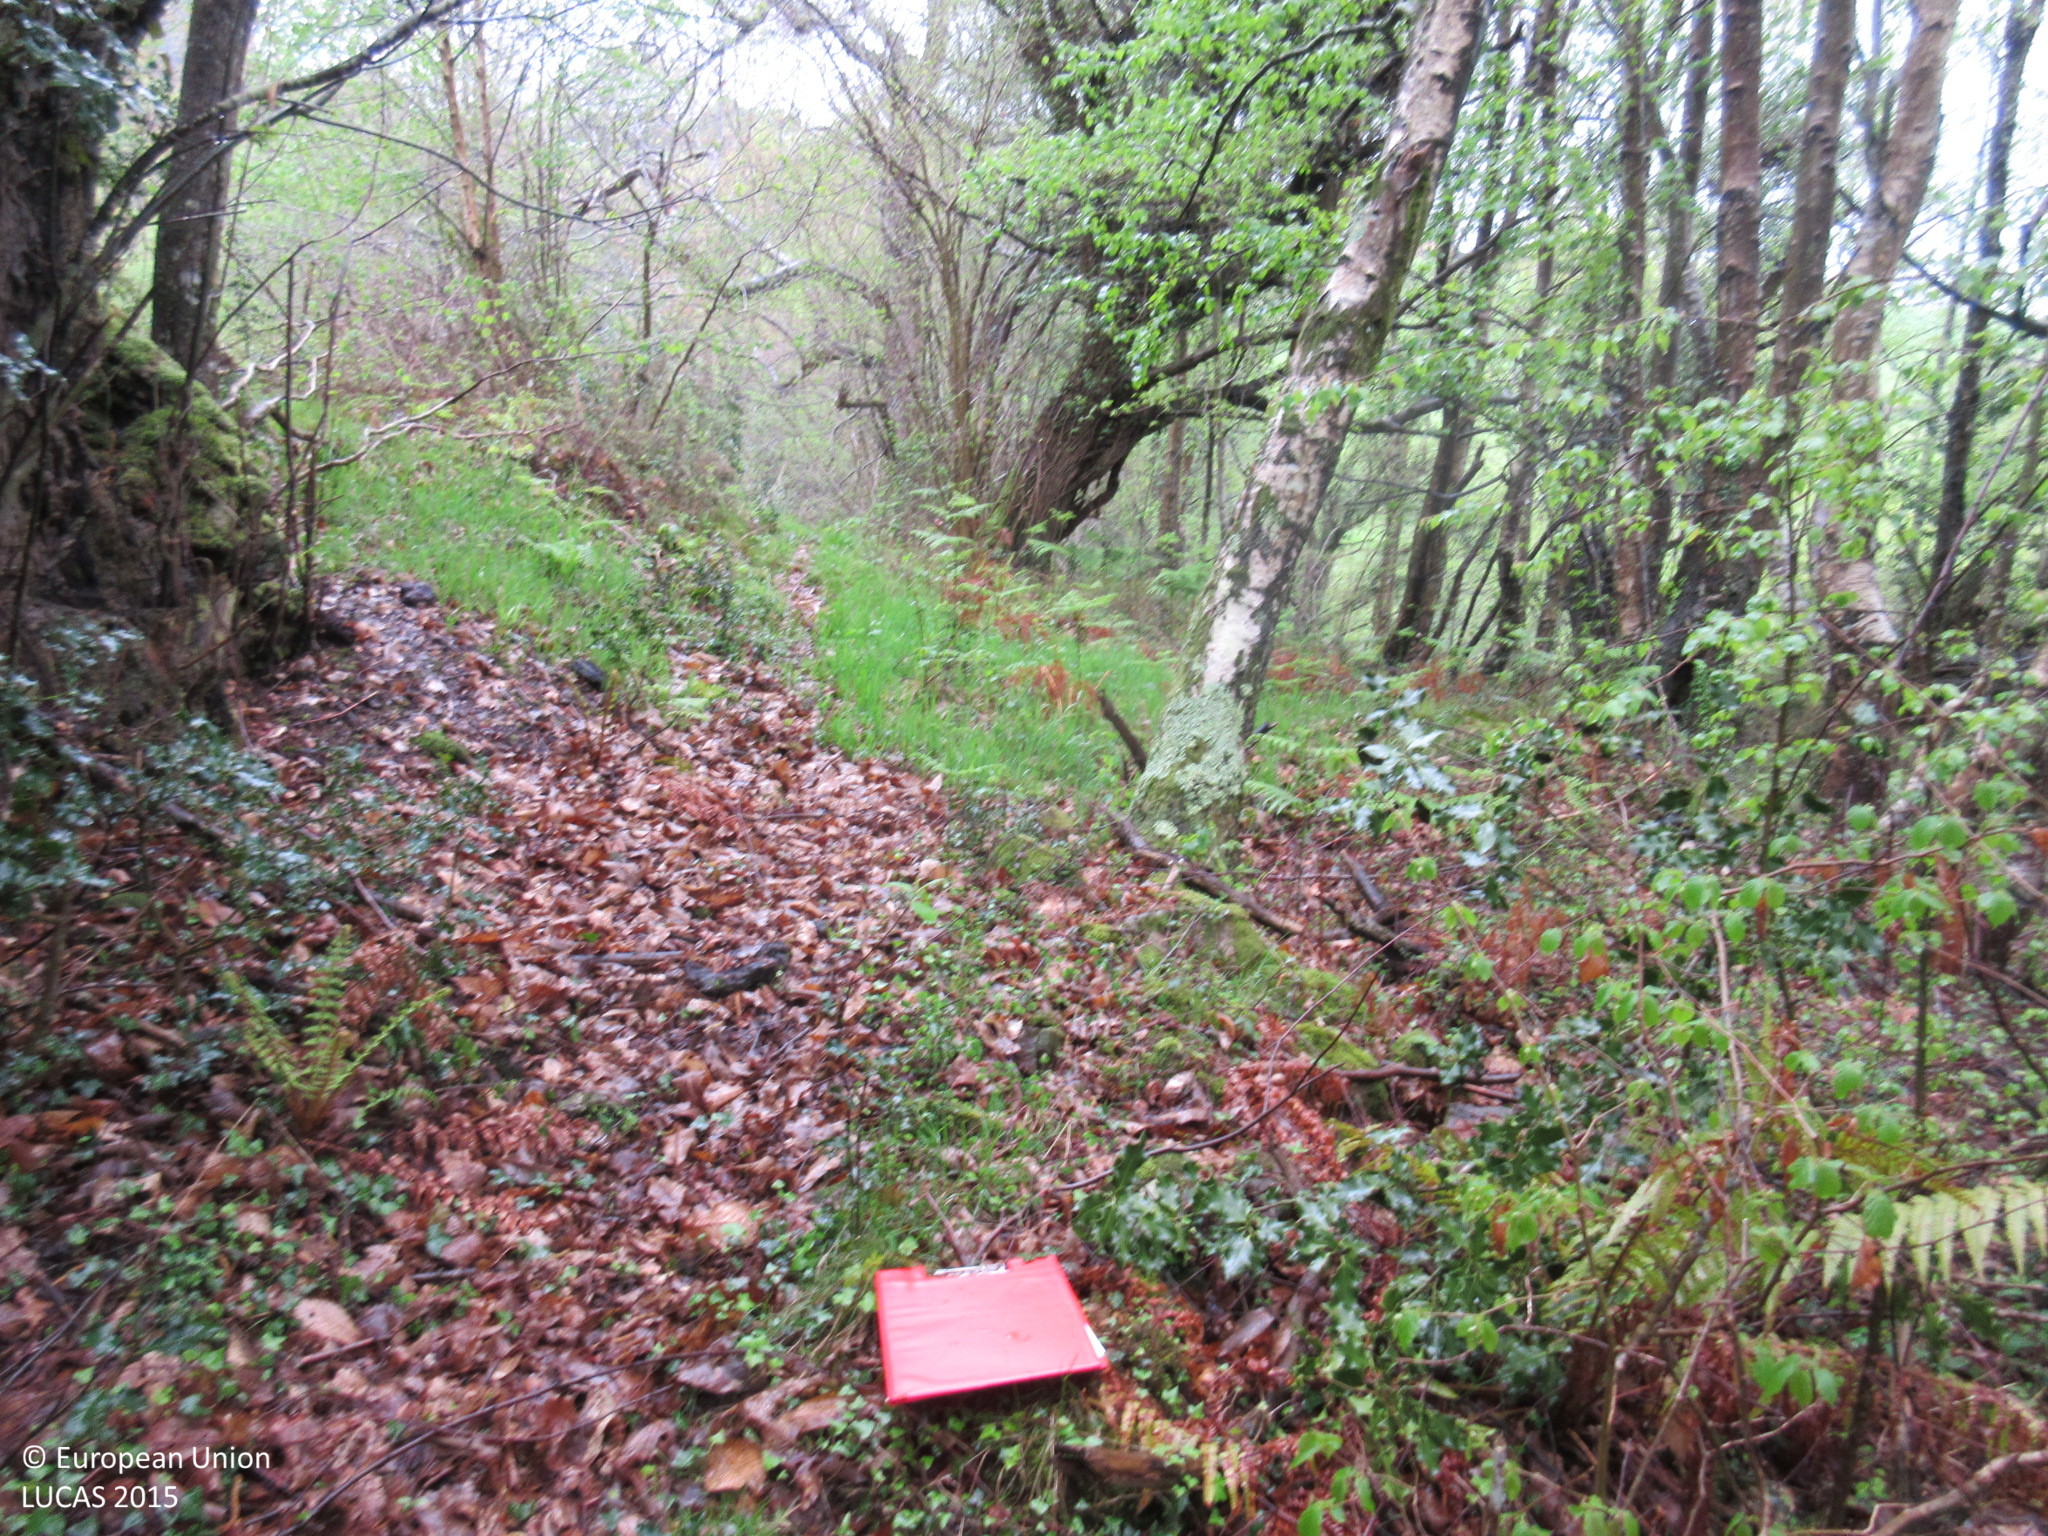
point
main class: Woodland
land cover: Broadleaved woodland
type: acidophilous oak and oak-birch forest
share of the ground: > 75 %
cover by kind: broadleaved forest trees 100 %
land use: Forestry
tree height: > 5 m
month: April
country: ES
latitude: 43.4481
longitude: -5.2879
